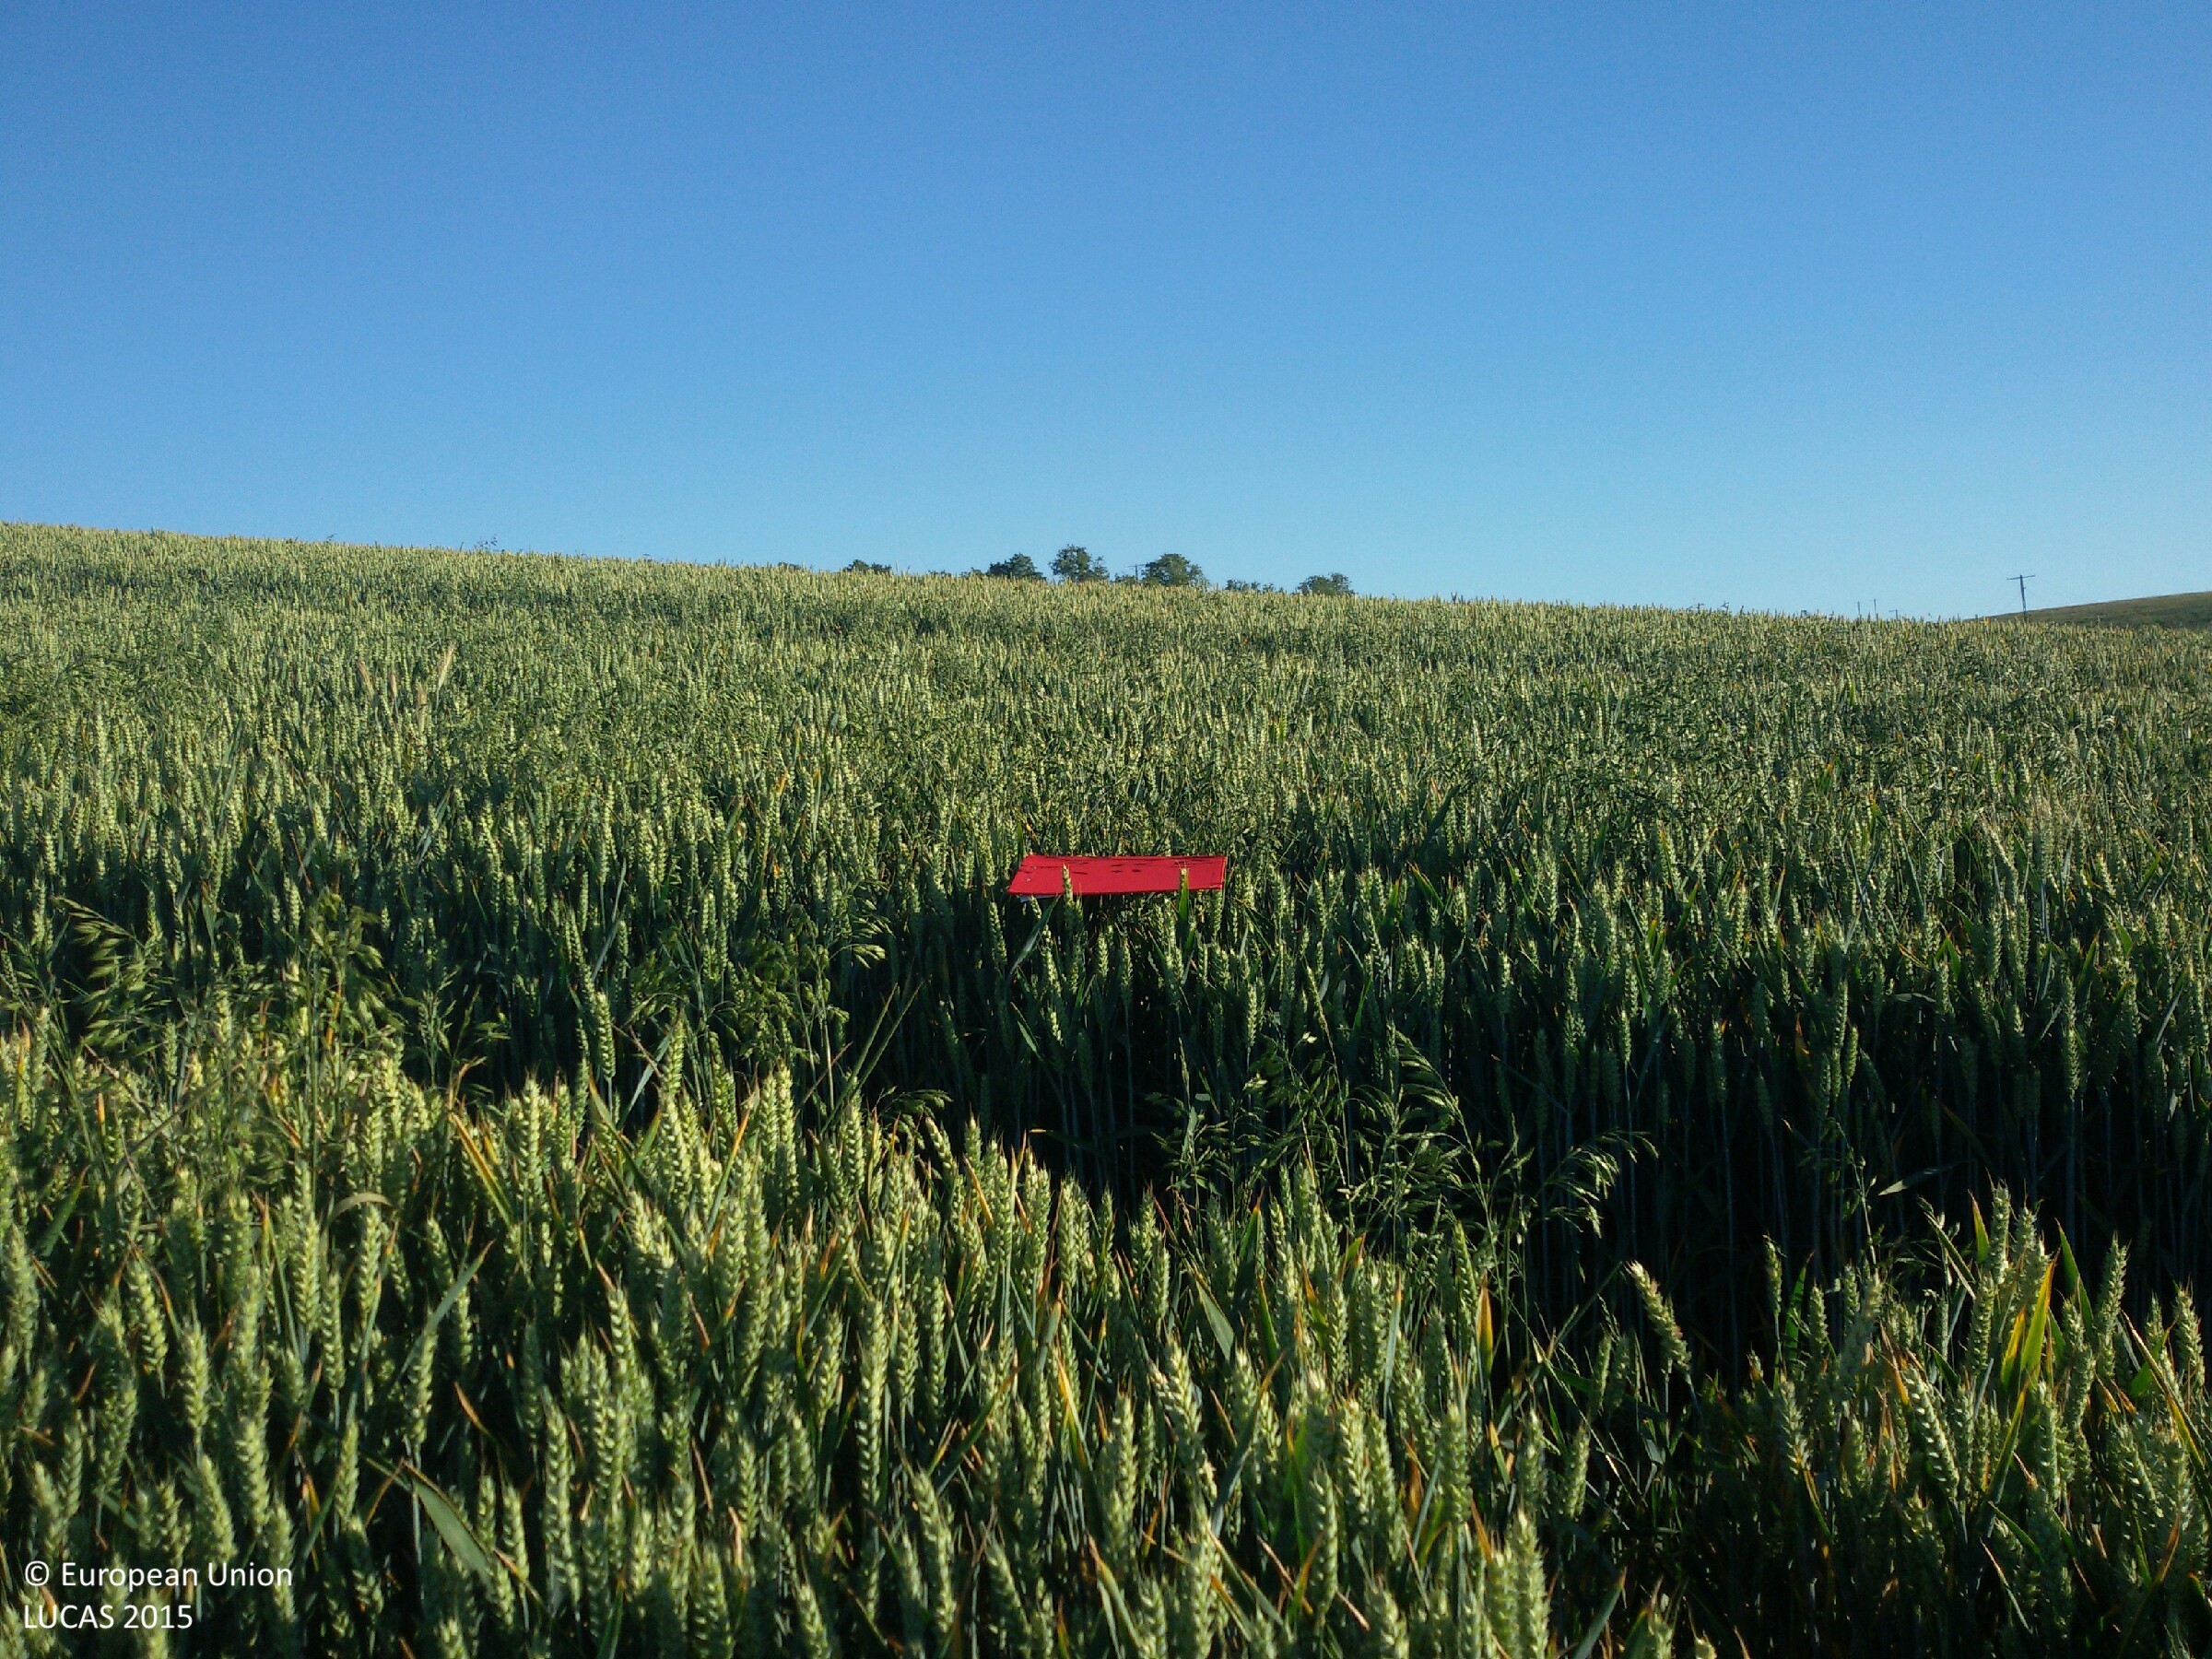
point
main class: Cropland
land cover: Common wheat
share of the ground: > 75 %
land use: Agriculture (excluding fallow land and kitchen gardens)
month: July
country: PL
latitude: 53.8925
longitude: 19.3218
